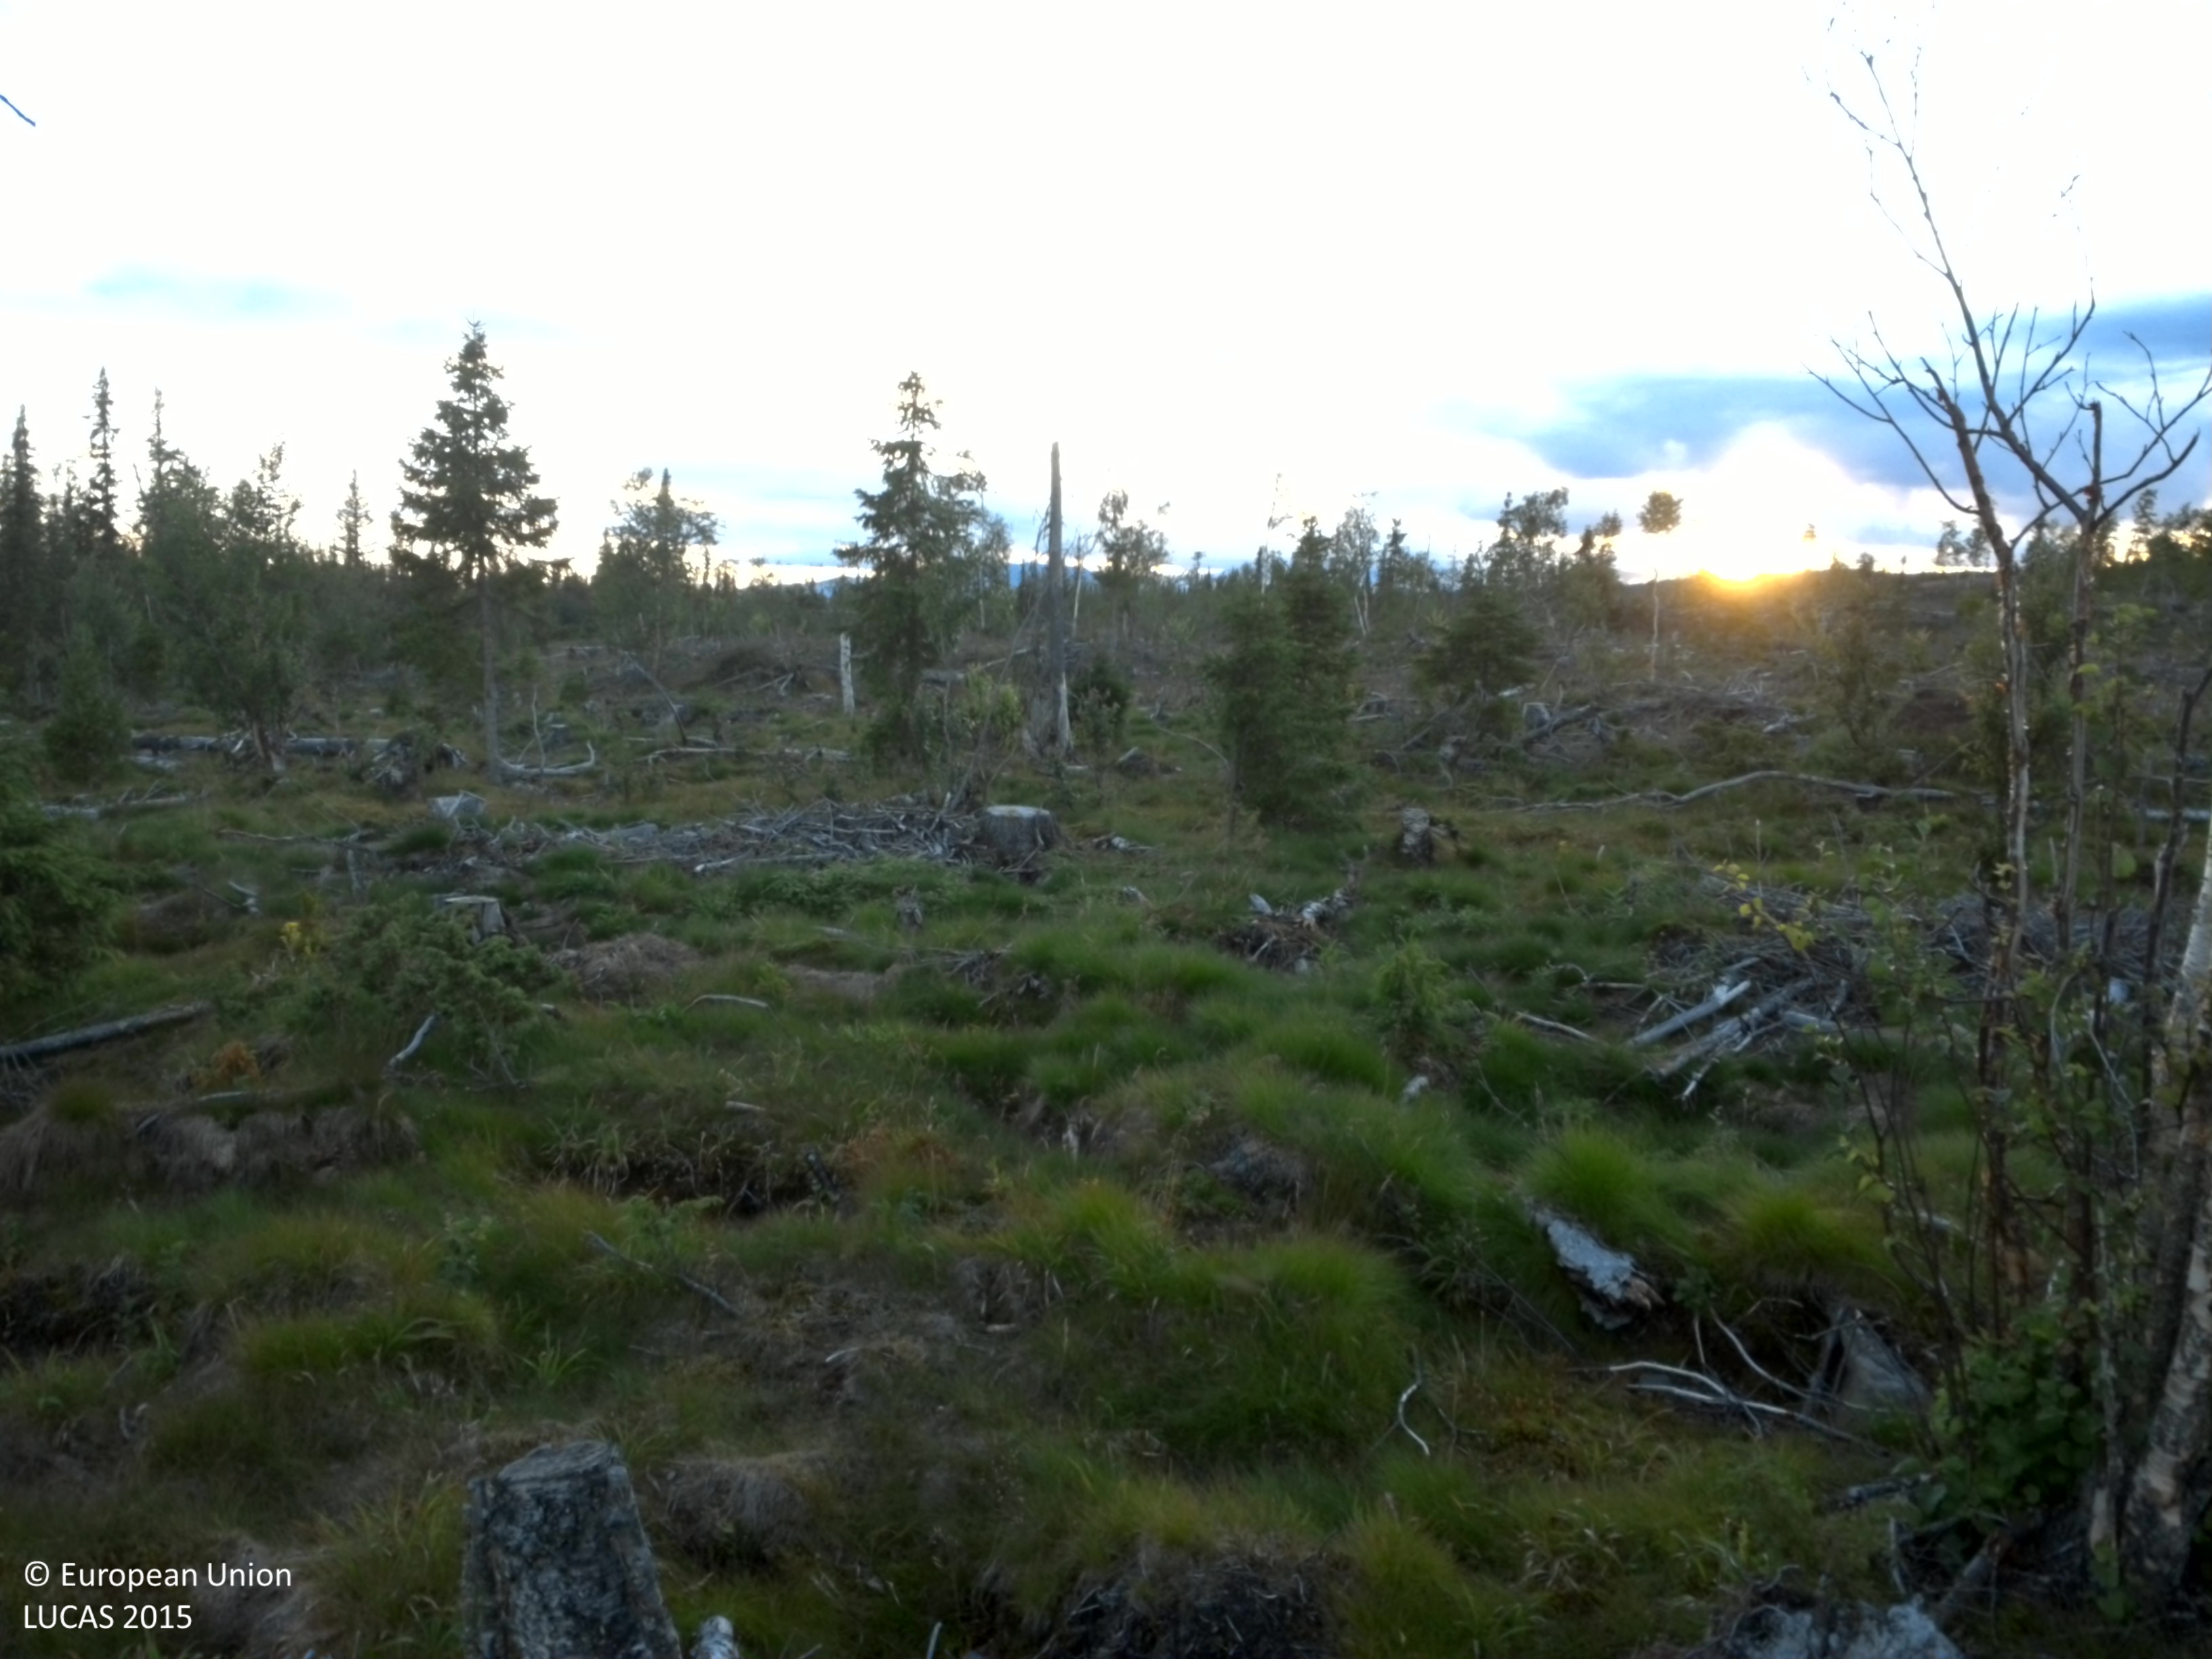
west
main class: Grassland
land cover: Grassland with sparse tree/shrub cover
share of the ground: > 75 %
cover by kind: herbaceous plants 90 %, coniferous forest trees 5 %, shrubs 5 %
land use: Forestry
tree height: < 5 m
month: August
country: SE
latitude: 65.0346
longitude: 15.8056
